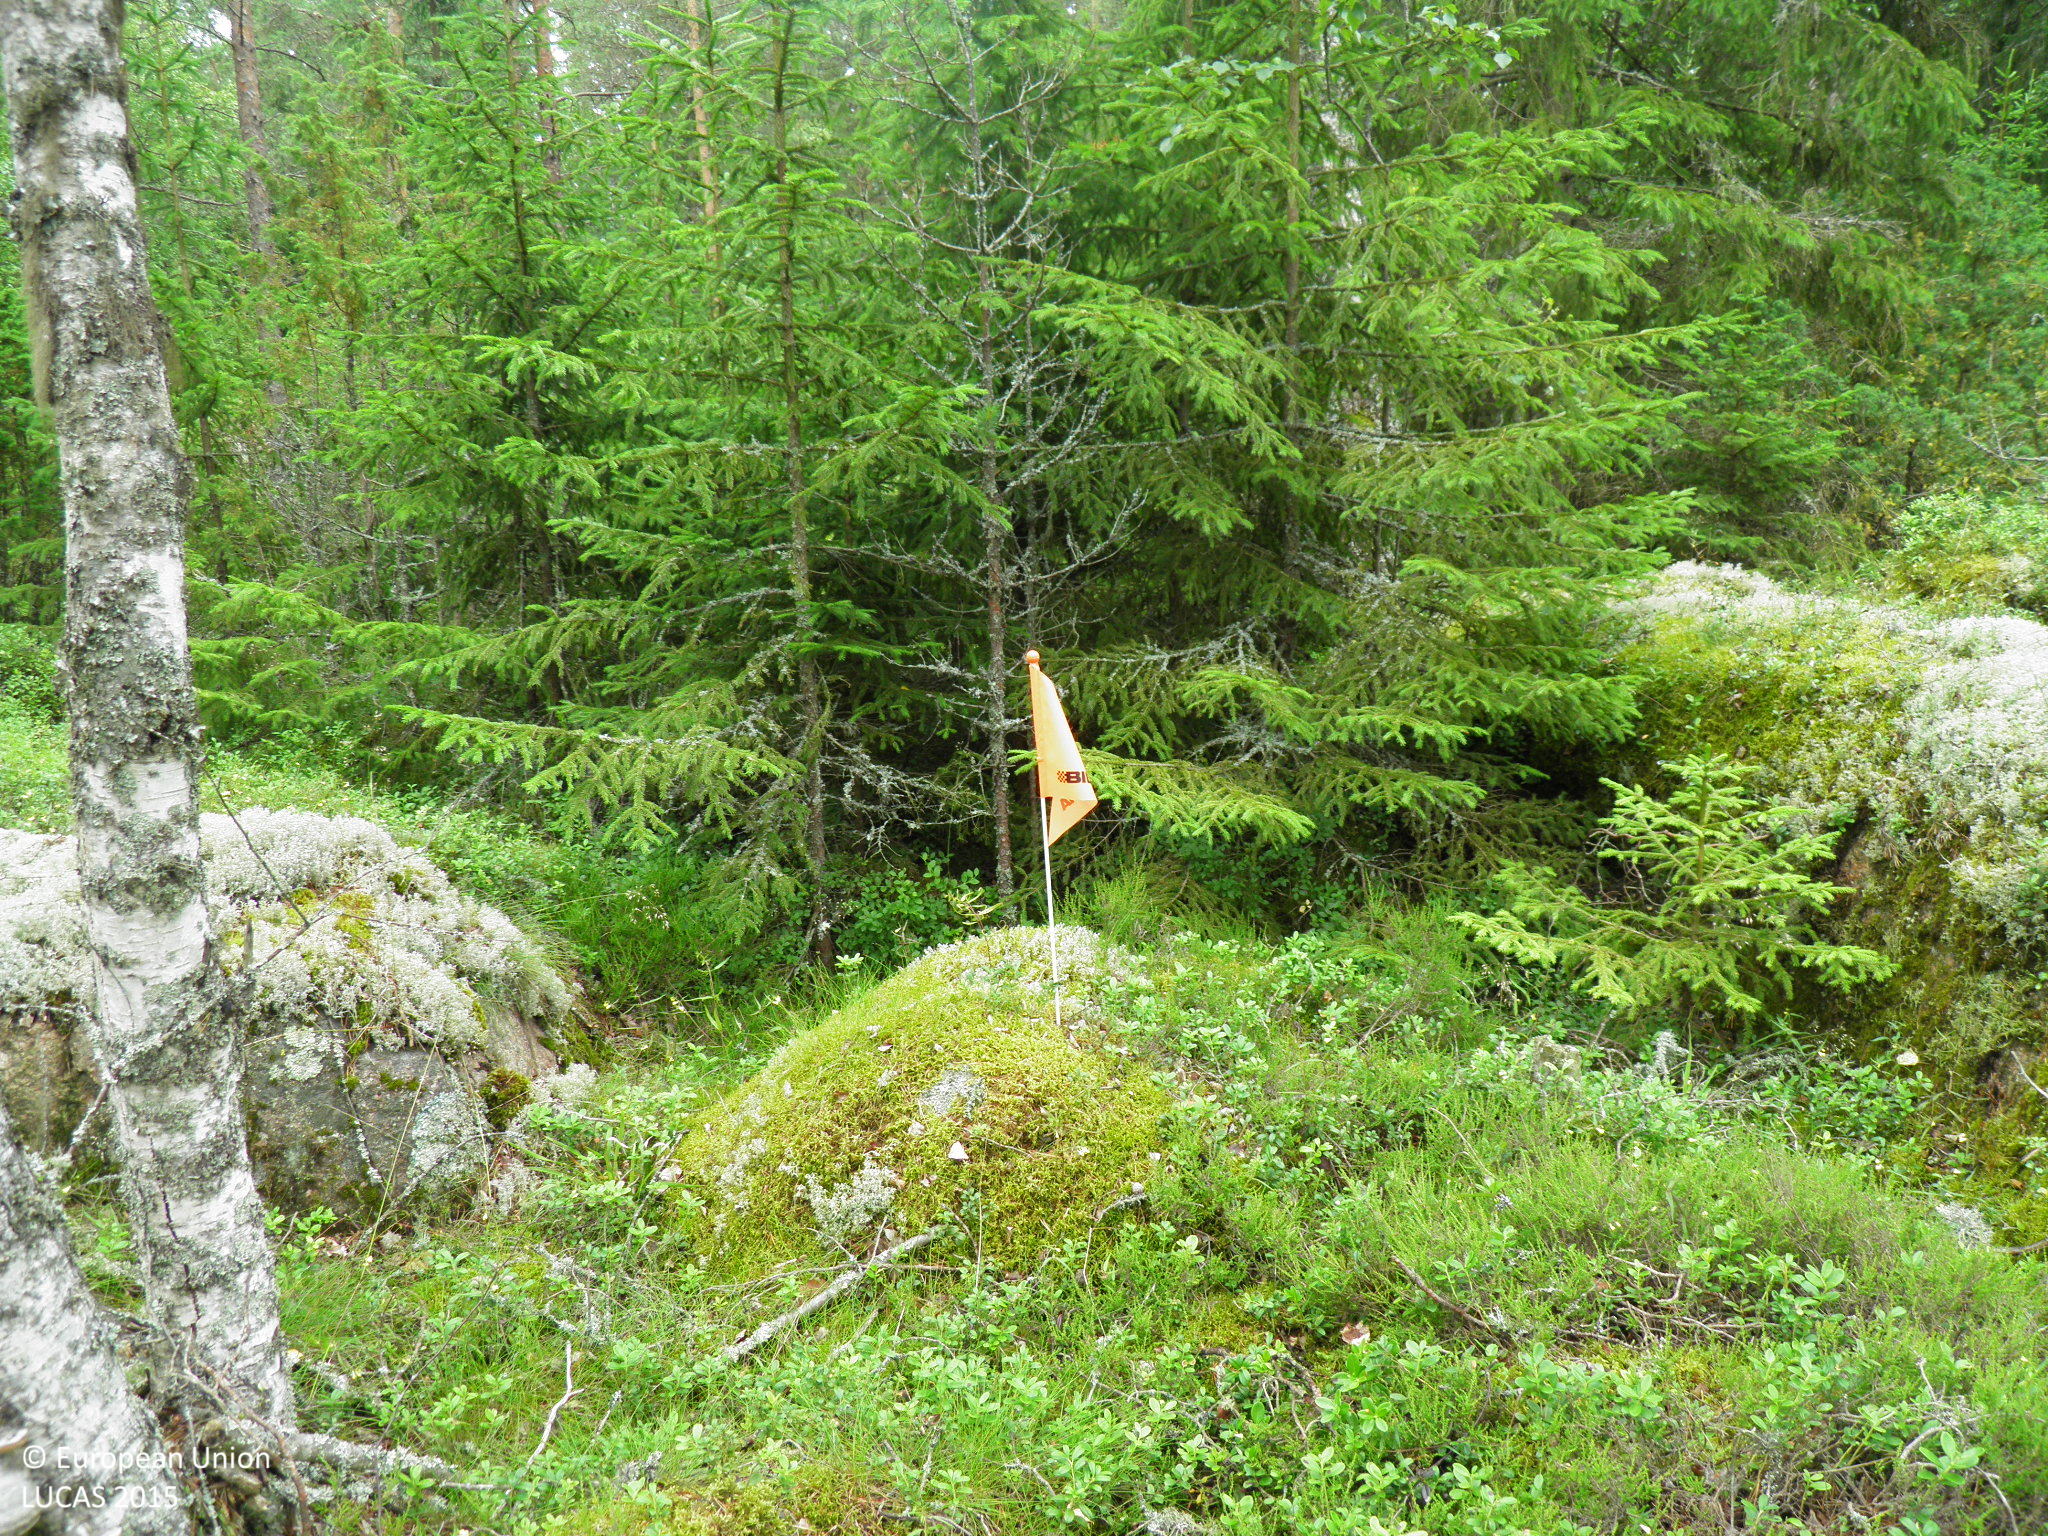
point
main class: Woodland
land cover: Other coniferous woodland
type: hemiboreal forest and nemoral coniferous forest and mixed broadleaved-coniferous forest
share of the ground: 25 - 50 %
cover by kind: lichens and mosses 50 %, coniferous forest trees 30 %, broadleaved forest trees 10 %, shrubs 10 %
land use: Forestry
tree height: > 5 m
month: July
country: FI
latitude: 60.6099
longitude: 21.6208
